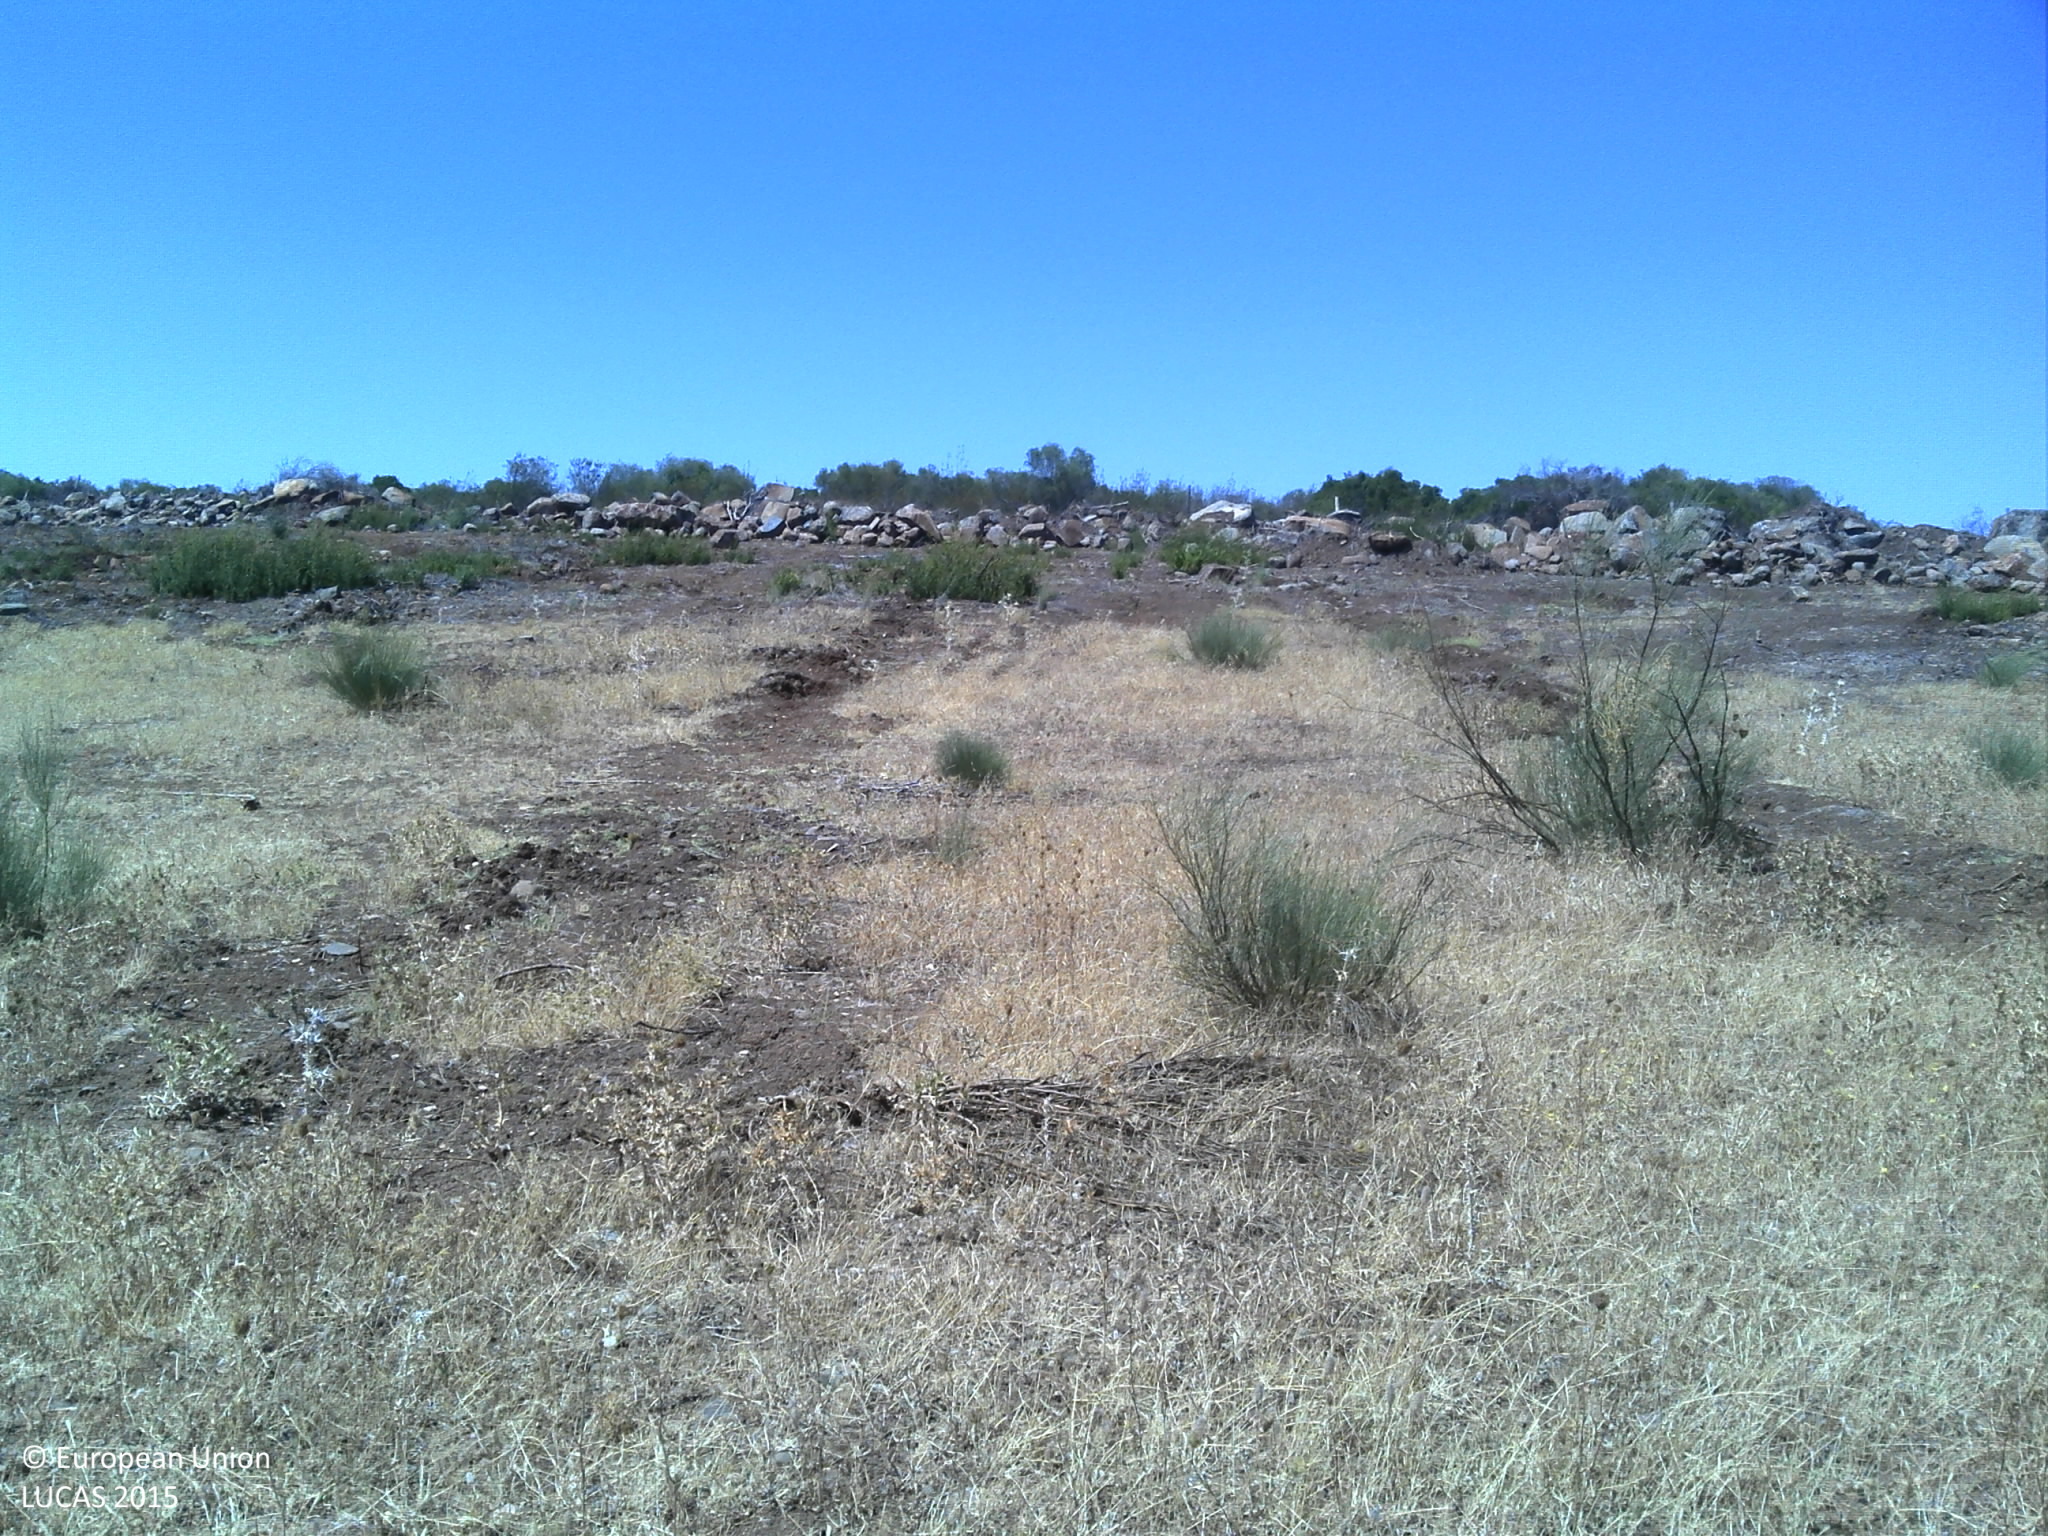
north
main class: Grassland
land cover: Grassland without tree/shrub cover
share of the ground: 50 - 75 %
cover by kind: herbaceous plants 70 %, unconsolidated bare surface 30 %
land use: Agriculture (excluding fallow land and kitchen gardens)
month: July
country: PT
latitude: 38.0592
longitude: -8.0519
